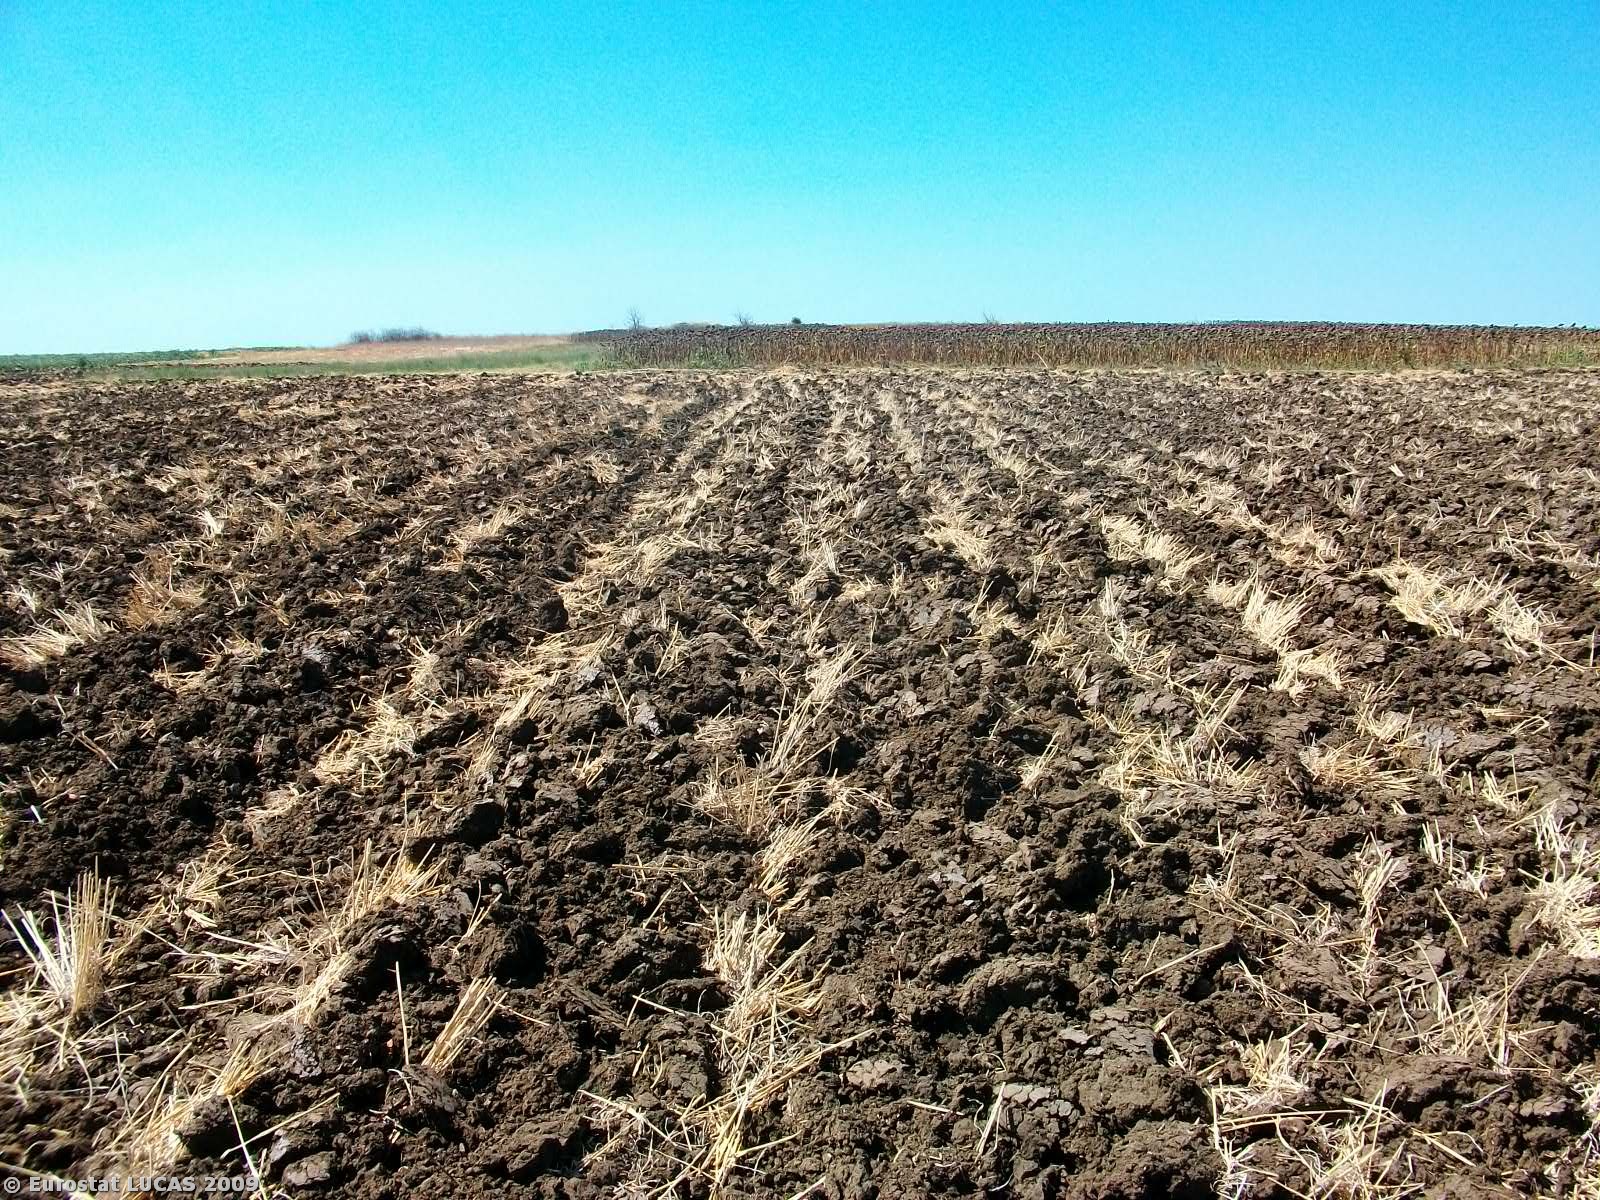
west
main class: Cropland
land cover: Common wheat
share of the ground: < 10 %
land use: Agriculture (excluding fallow land and kitchen gardens)
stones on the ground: < 10 %
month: August
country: GR
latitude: 41.3924
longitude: 26.3266
